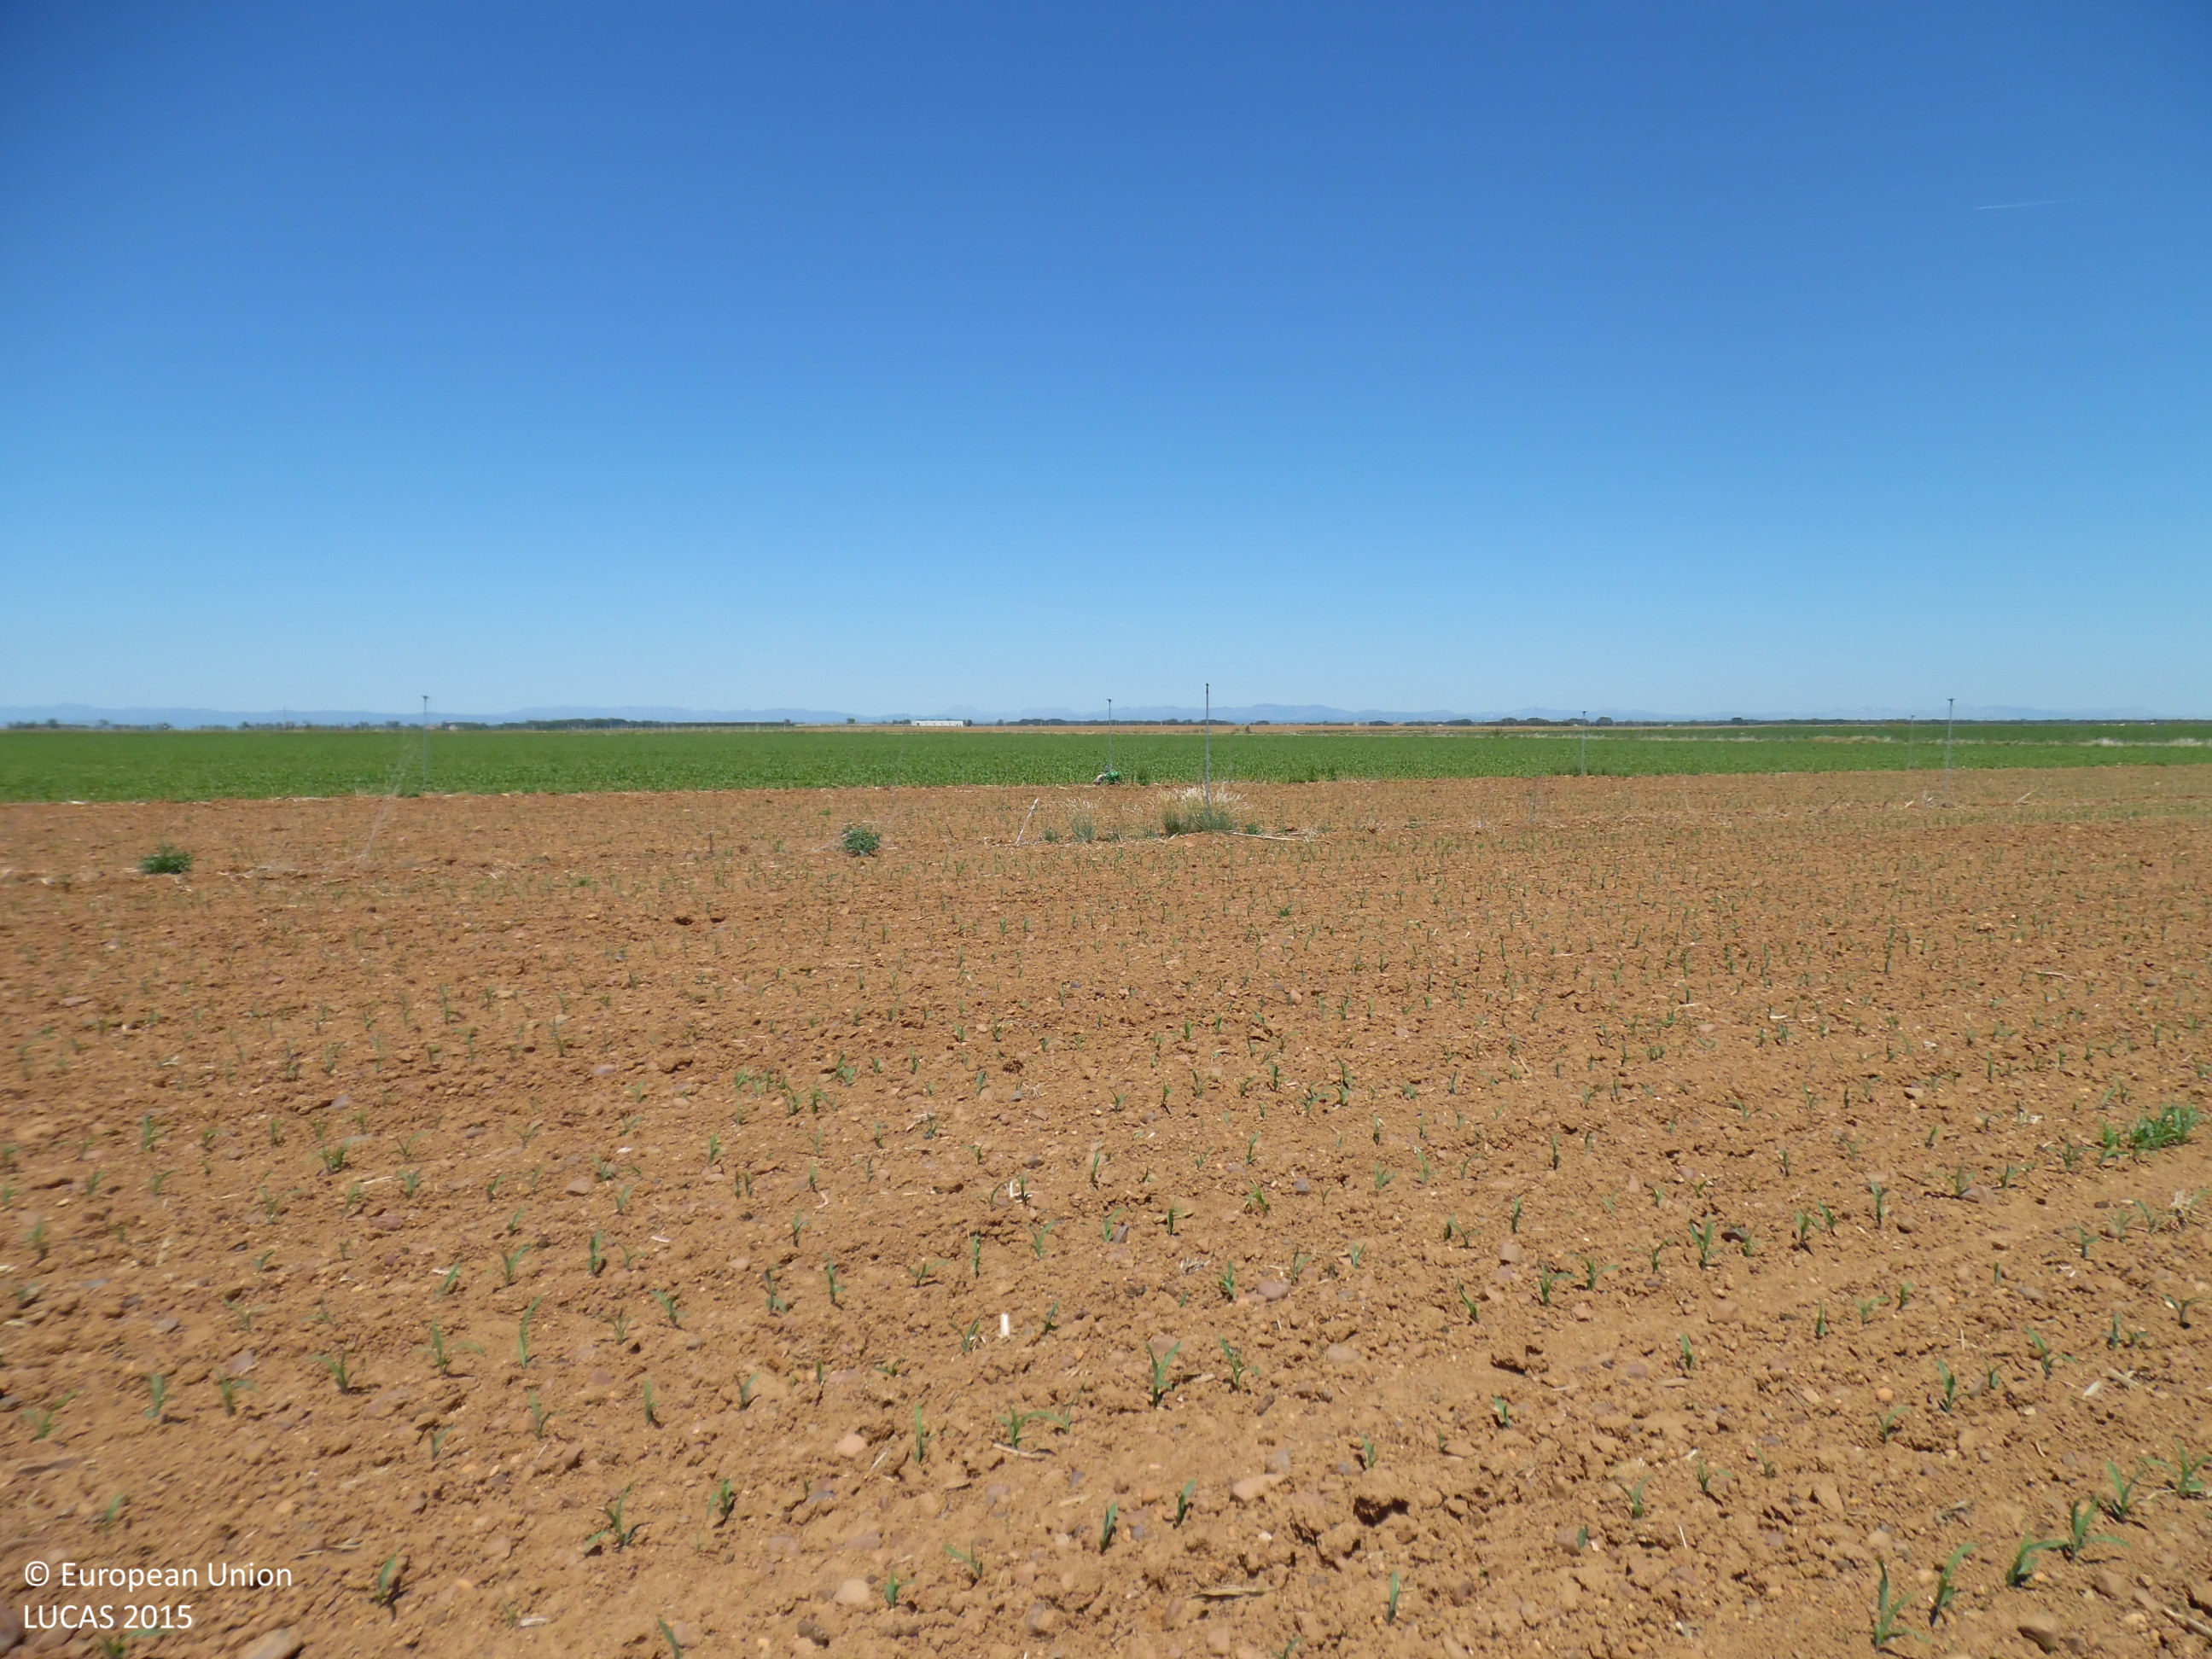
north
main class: Cropland
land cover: Maize
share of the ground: < 10 %
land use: Agriculture (excluding fallow land and kitchen gardens)
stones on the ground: 10 - 25 %
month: June
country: ES
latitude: 42.3965
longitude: -5.6835
